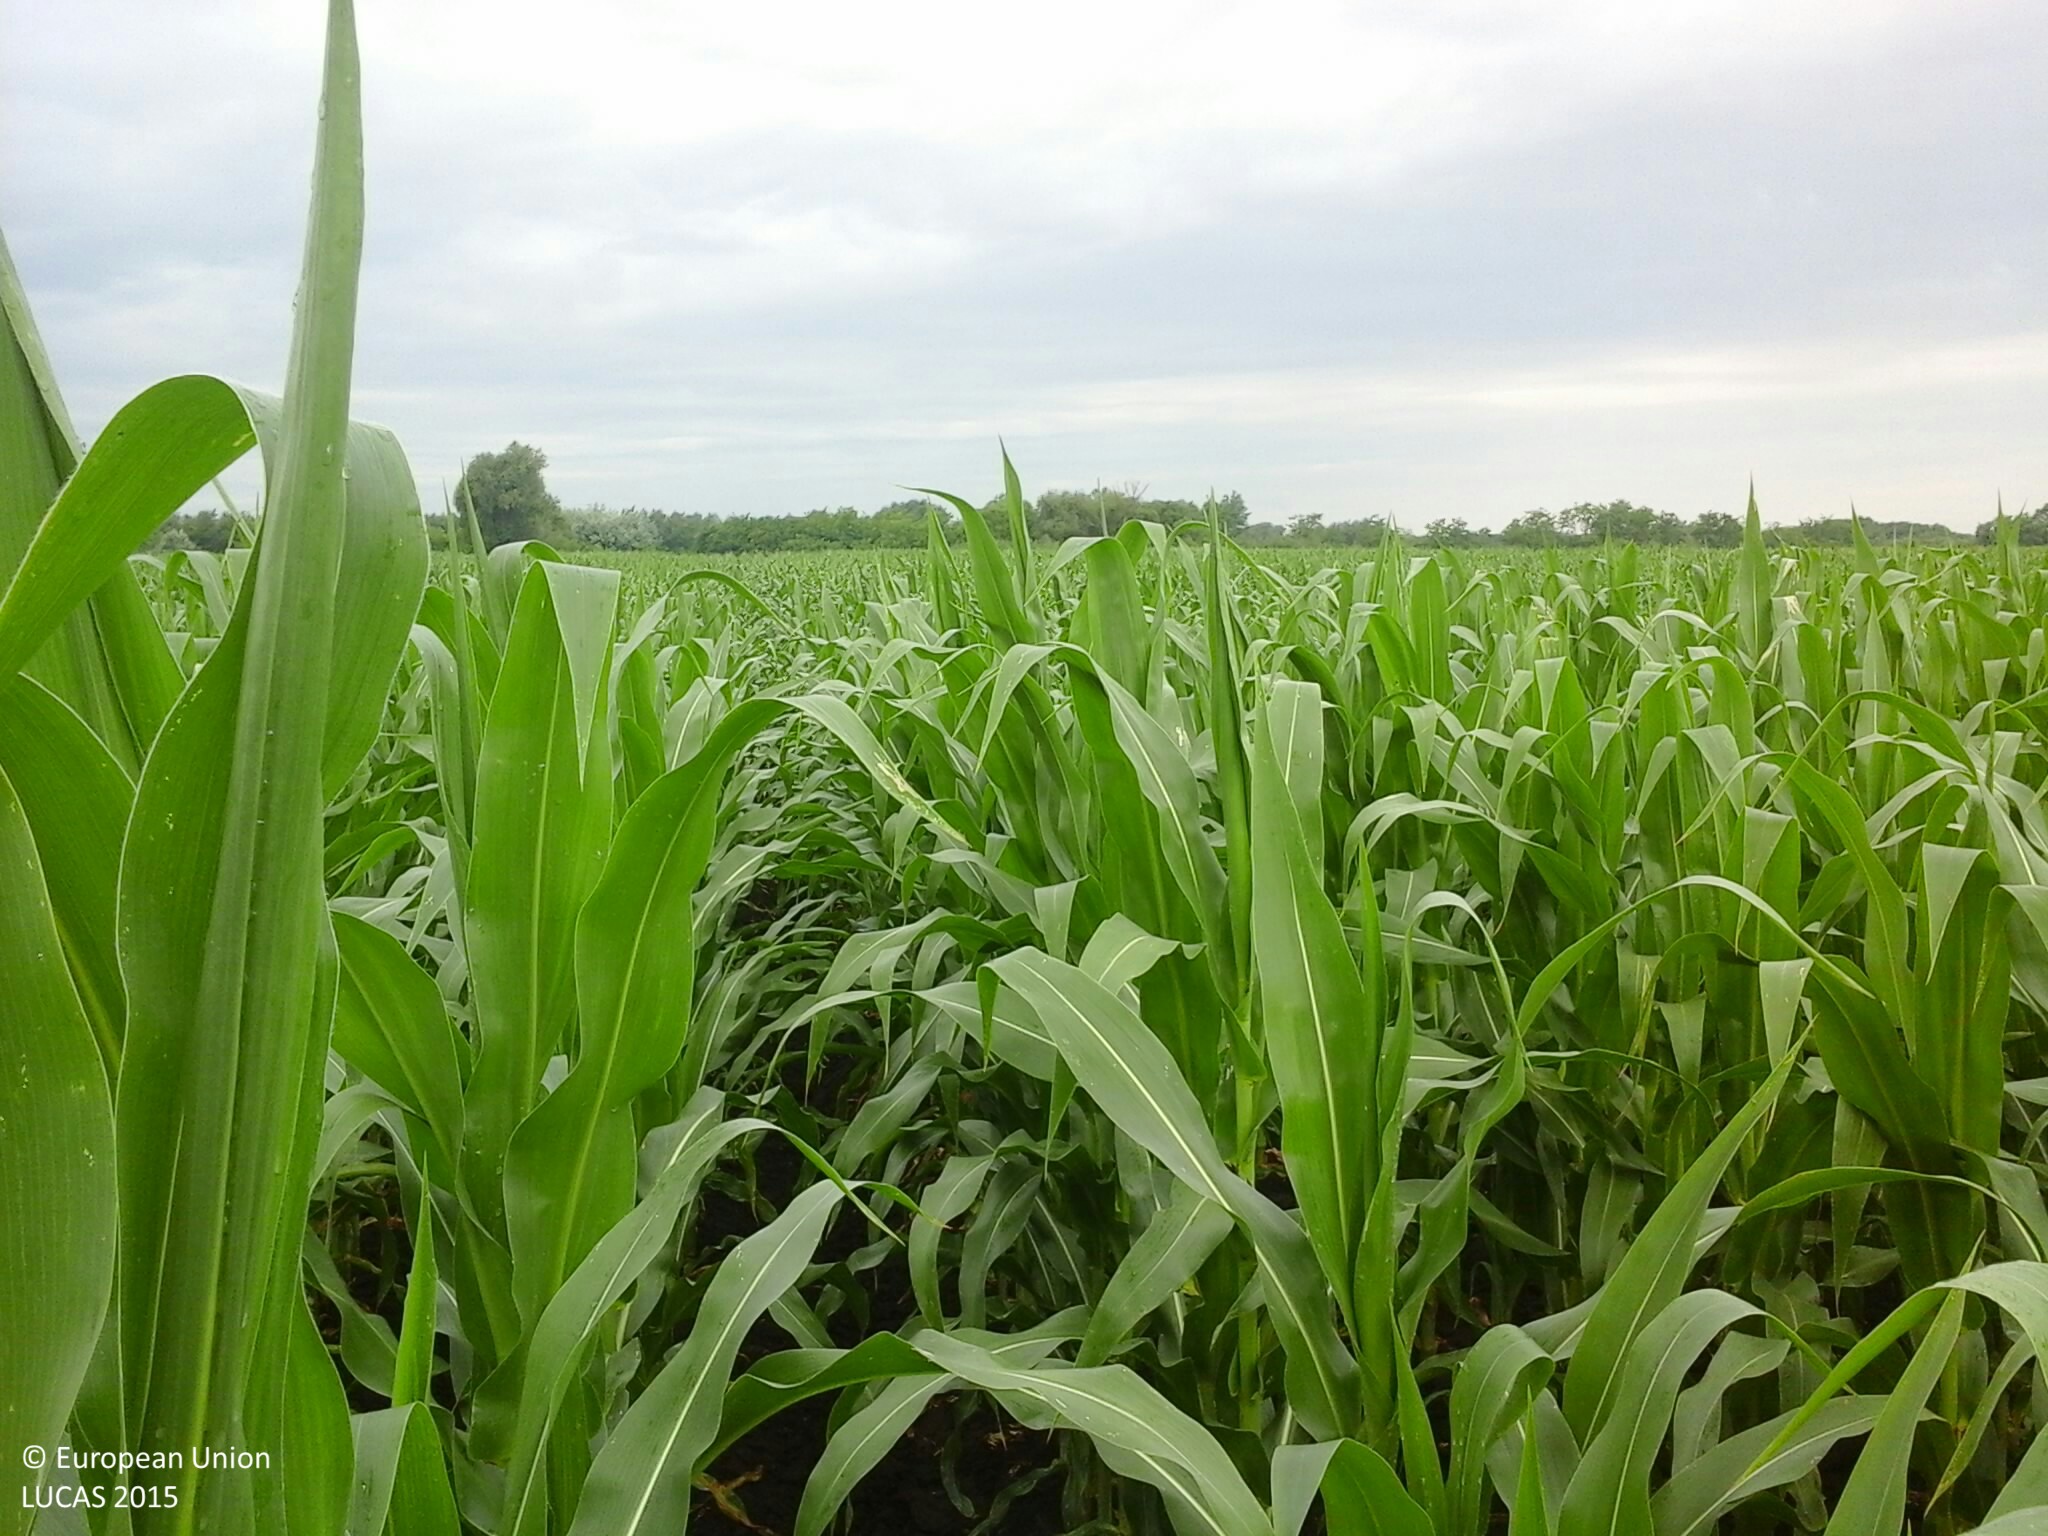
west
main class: Cropland
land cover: Maize
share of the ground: > 75 %
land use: Agriculture (excluding fallow land and kitchen gardens)
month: July
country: HU
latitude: 47.7898
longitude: 21.9439
